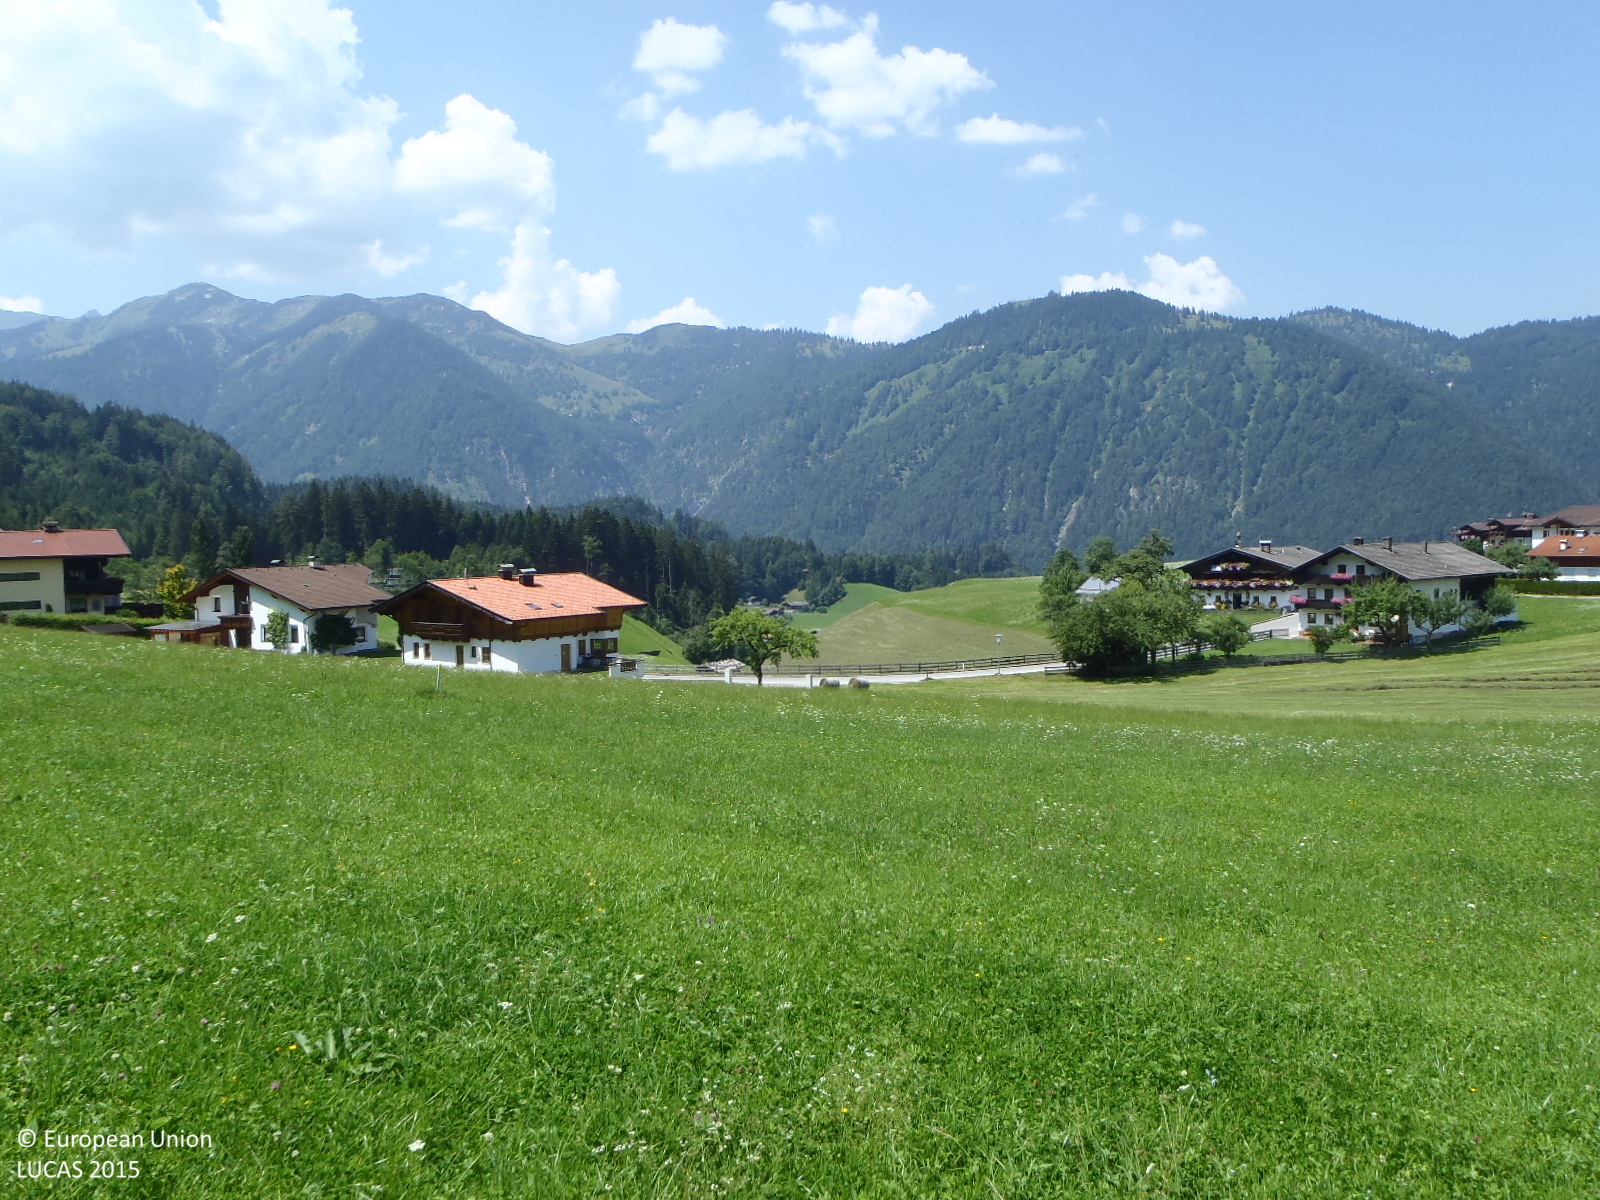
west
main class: Grassland
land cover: Grassland without tree/shrub cover
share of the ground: > 75 %
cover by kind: herbaceous plants 100 %
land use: Agriculture (excluding fallow land and kitchen gardens)
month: July
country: AT
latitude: 47.4871
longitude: 11.8964
